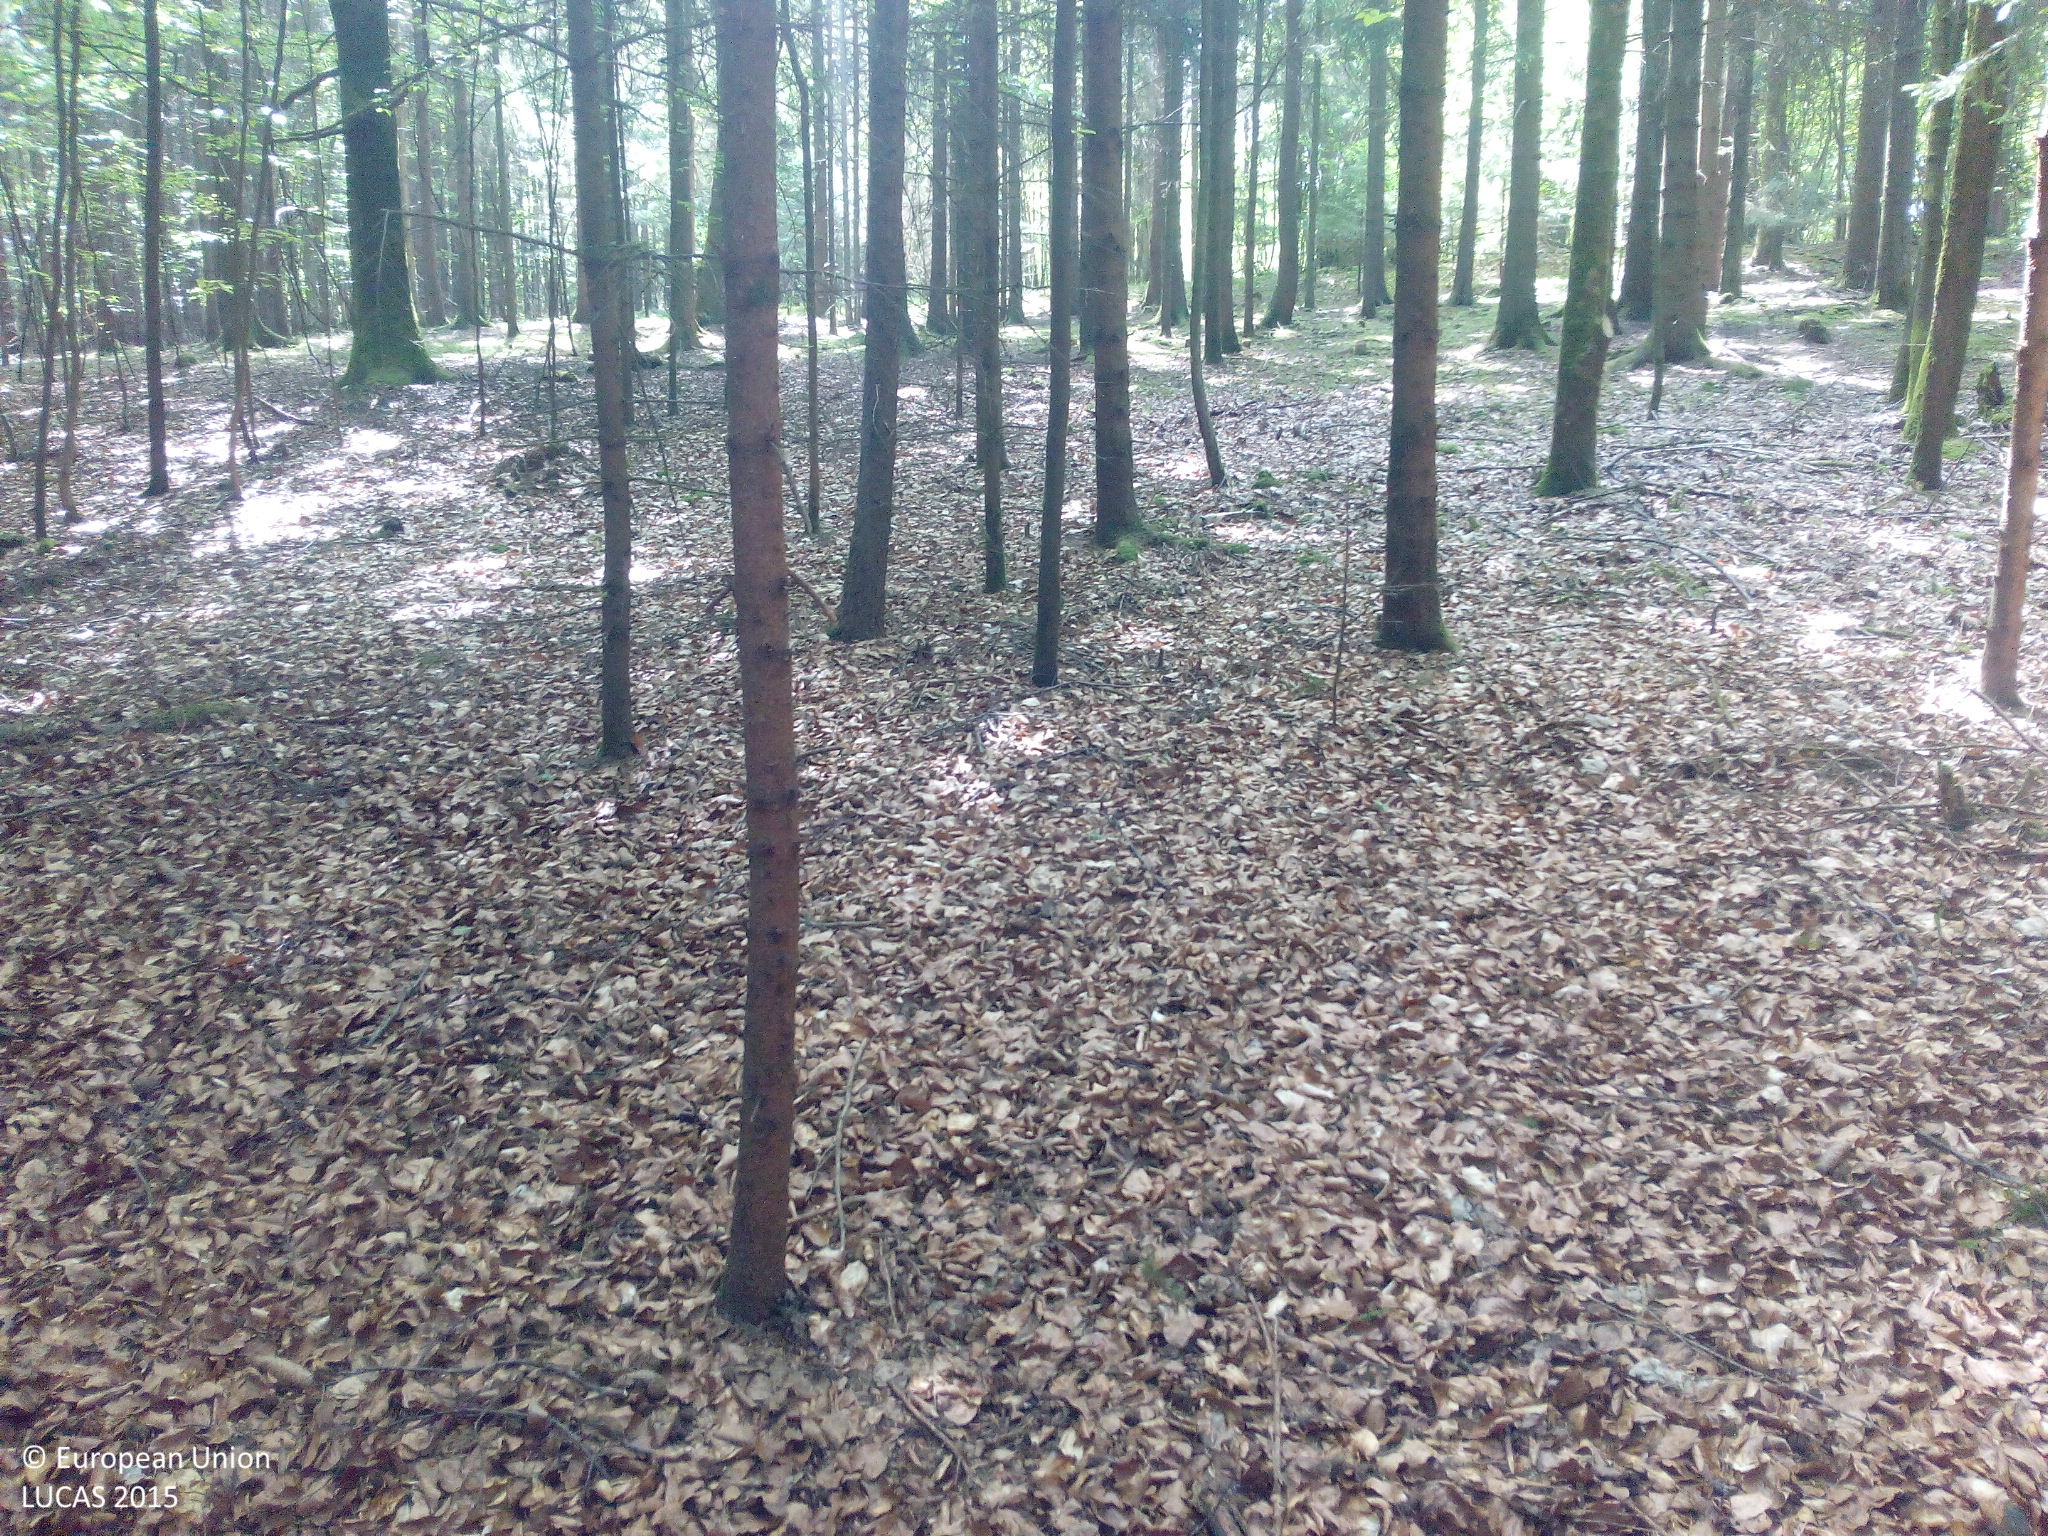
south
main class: Woodland
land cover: Spruce dominated coniferous woodland
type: hemiboreal forest and nemoral coniferous forest and mixed broadleaved-coniferous forest
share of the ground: > 75 %
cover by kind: coniferous forest trees 100 %
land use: Forestry
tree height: > 5 m
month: May
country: DE
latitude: 50.0713
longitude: 11.0755
